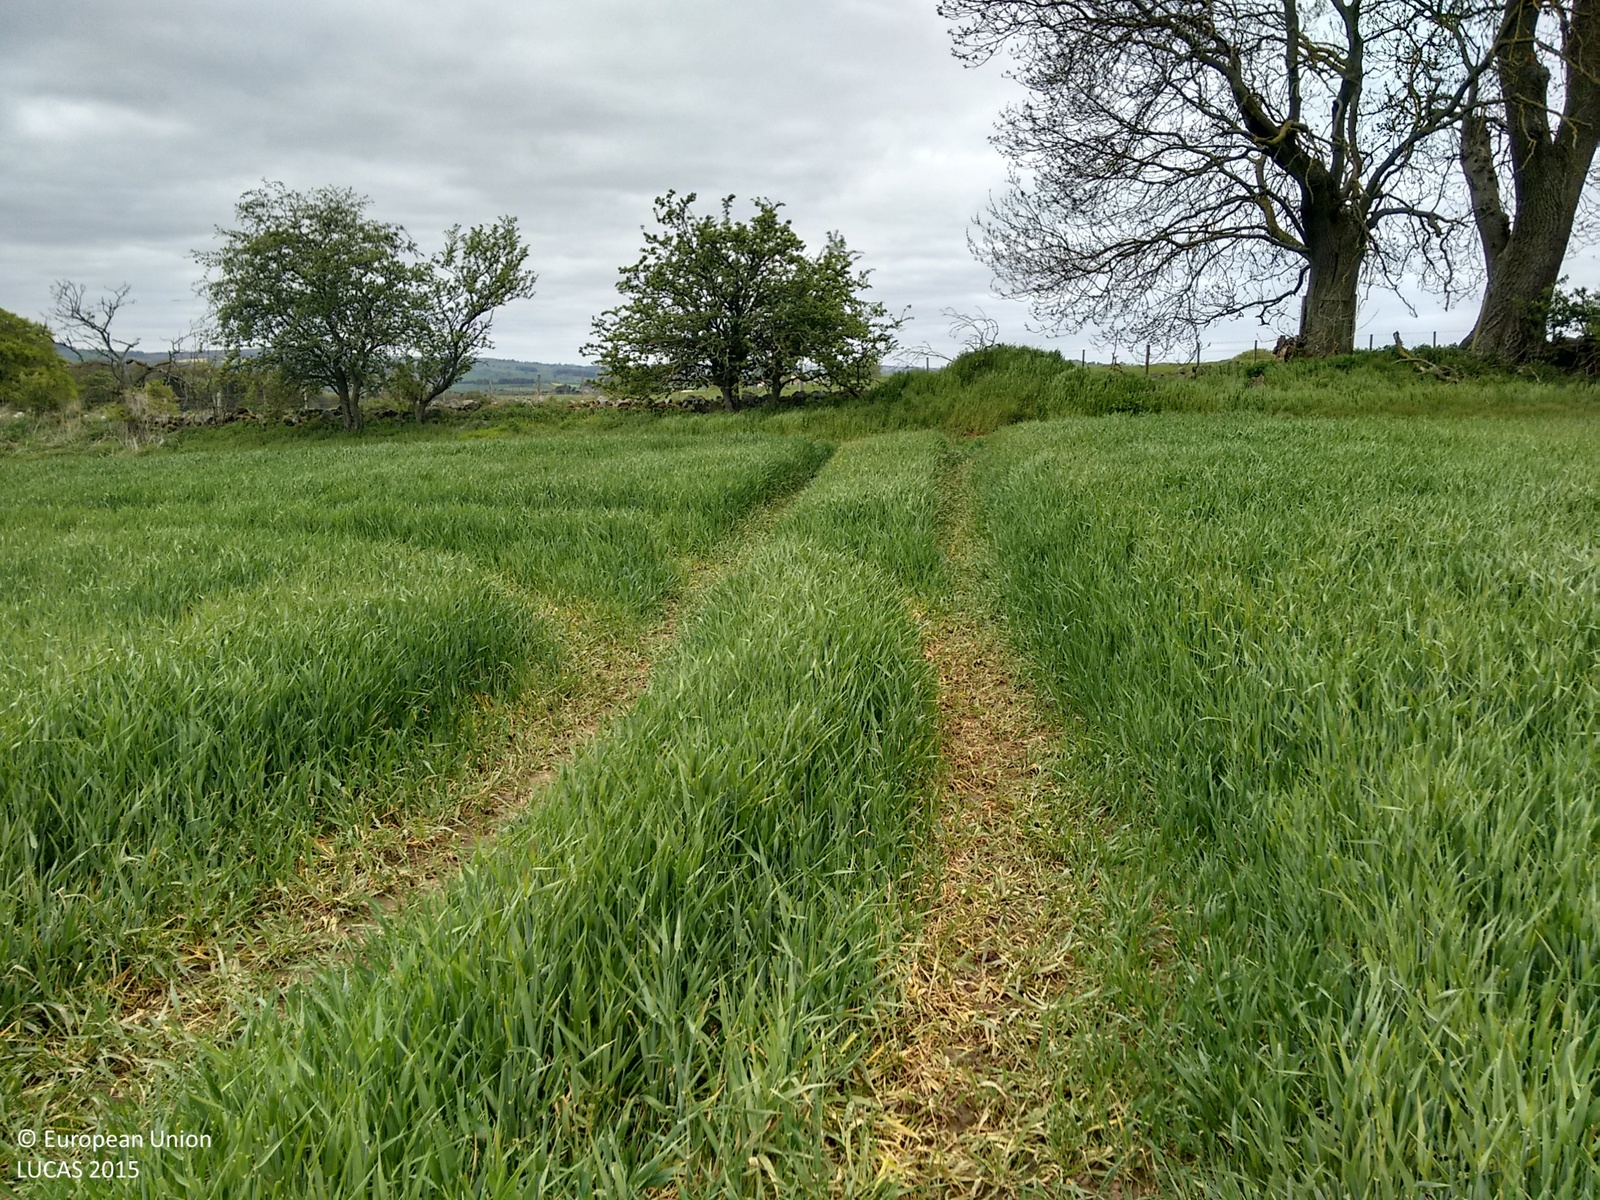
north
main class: Cropland
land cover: Barley
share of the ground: > 75 %
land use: Agriculture (excluding fallow land and kitchen gardens)
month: May
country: GB
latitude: 55.0668
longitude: -2.0977
